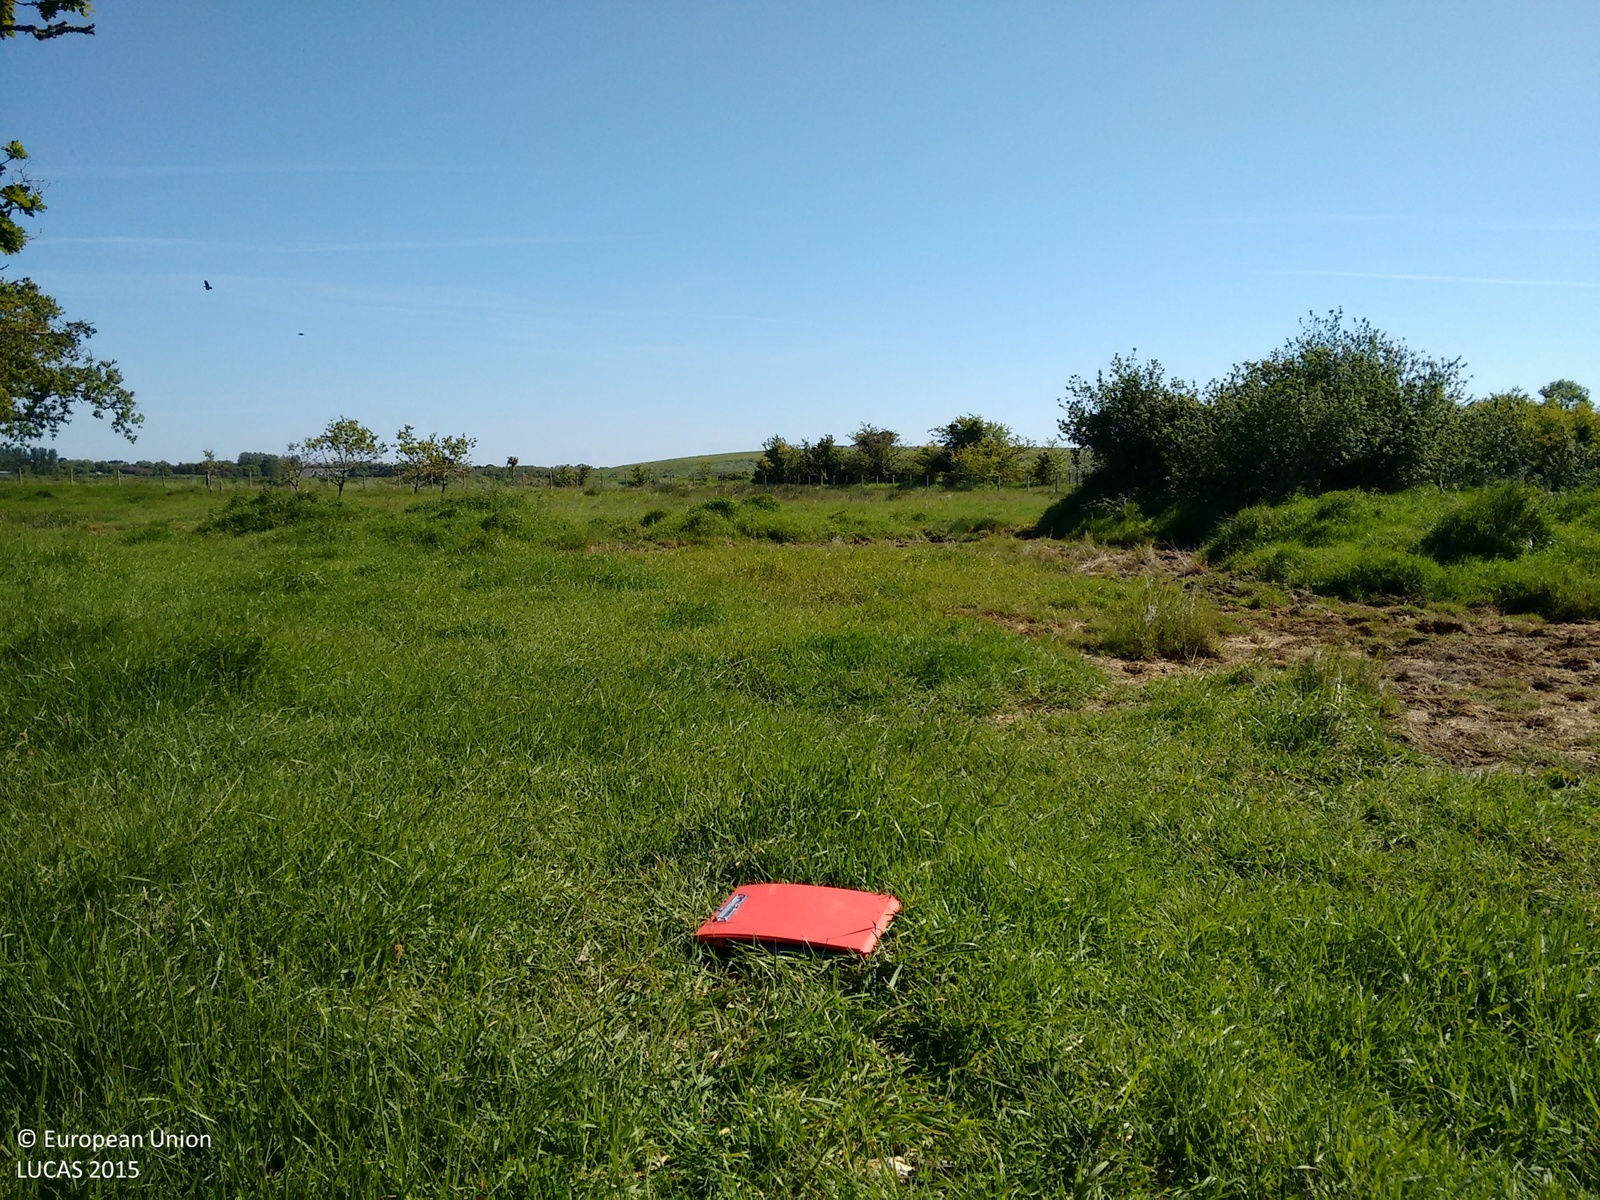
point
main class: Grassland
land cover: Grassland with sparse tree/shrub cover
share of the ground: > 75 %
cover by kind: herbaceous plants 80 %, unconsolidated bare surface 10 %, broadleaved forest trees 5 %, shrubs 5 %
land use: Agriculture (excluding fallow land and kitchen gardens)
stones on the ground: < 10 %
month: June
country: IE
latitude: 53.4980
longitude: -6.1717
